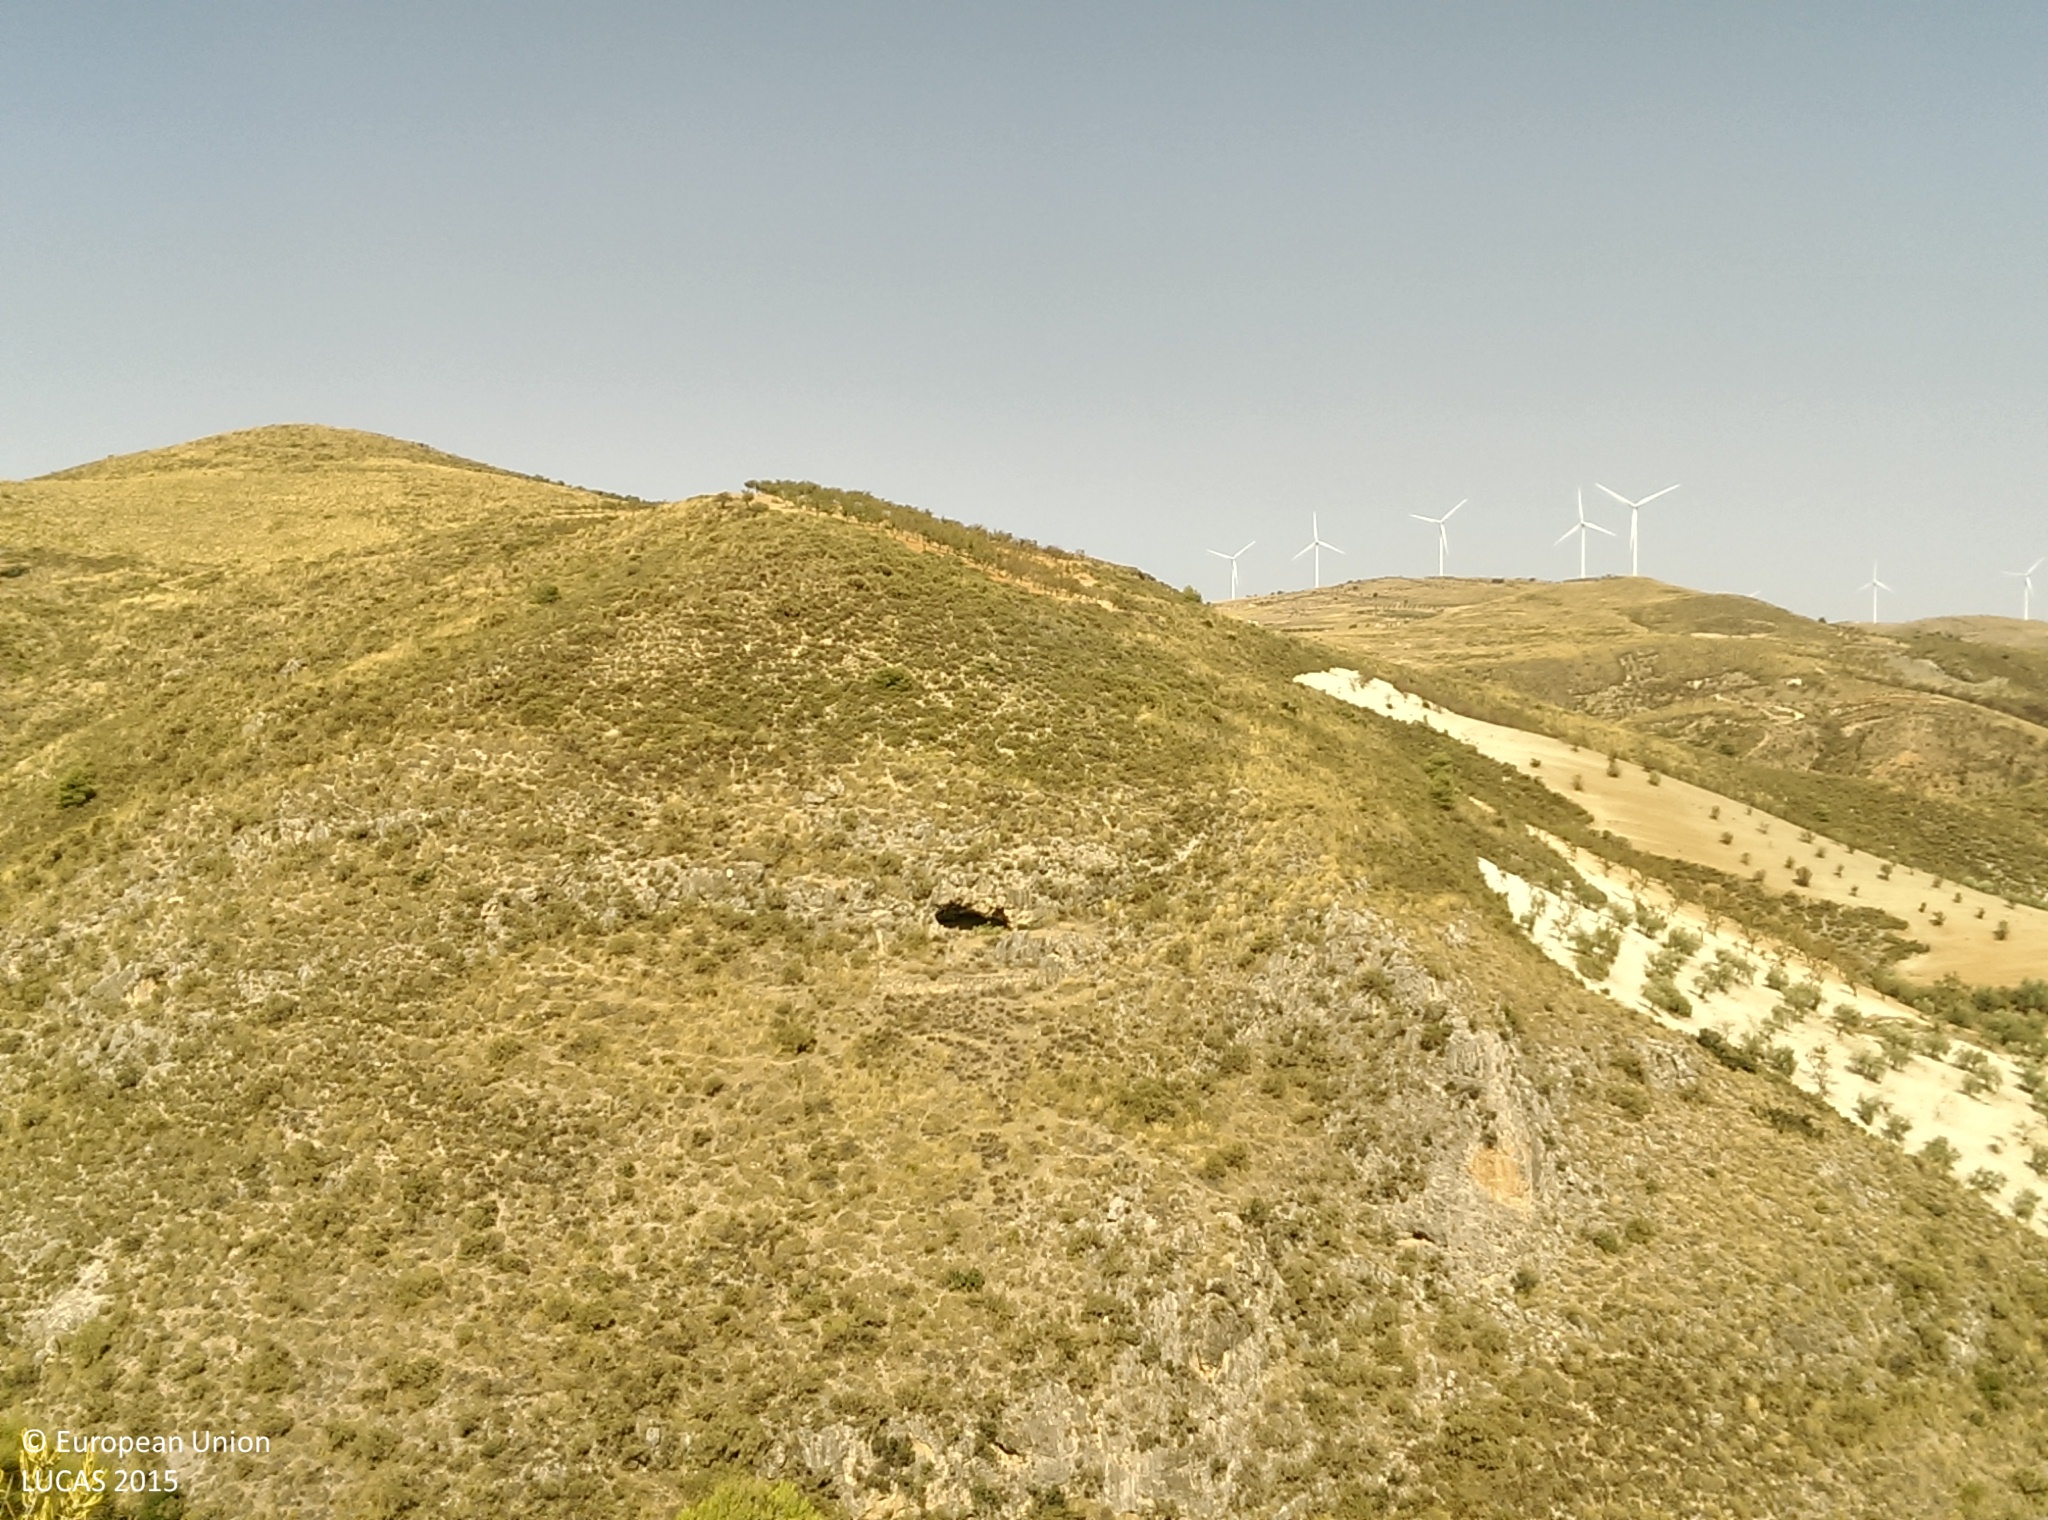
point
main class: Shrubland
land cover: Shrubland without tree cover
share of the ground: 50 - 75 %
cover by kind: shrubs 60 %, herbaceous plants 30 %, unconsolidated bare surface 10 %
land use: Abandoned areas
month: August
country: ES
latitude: 36.9775
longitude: -3.6579
